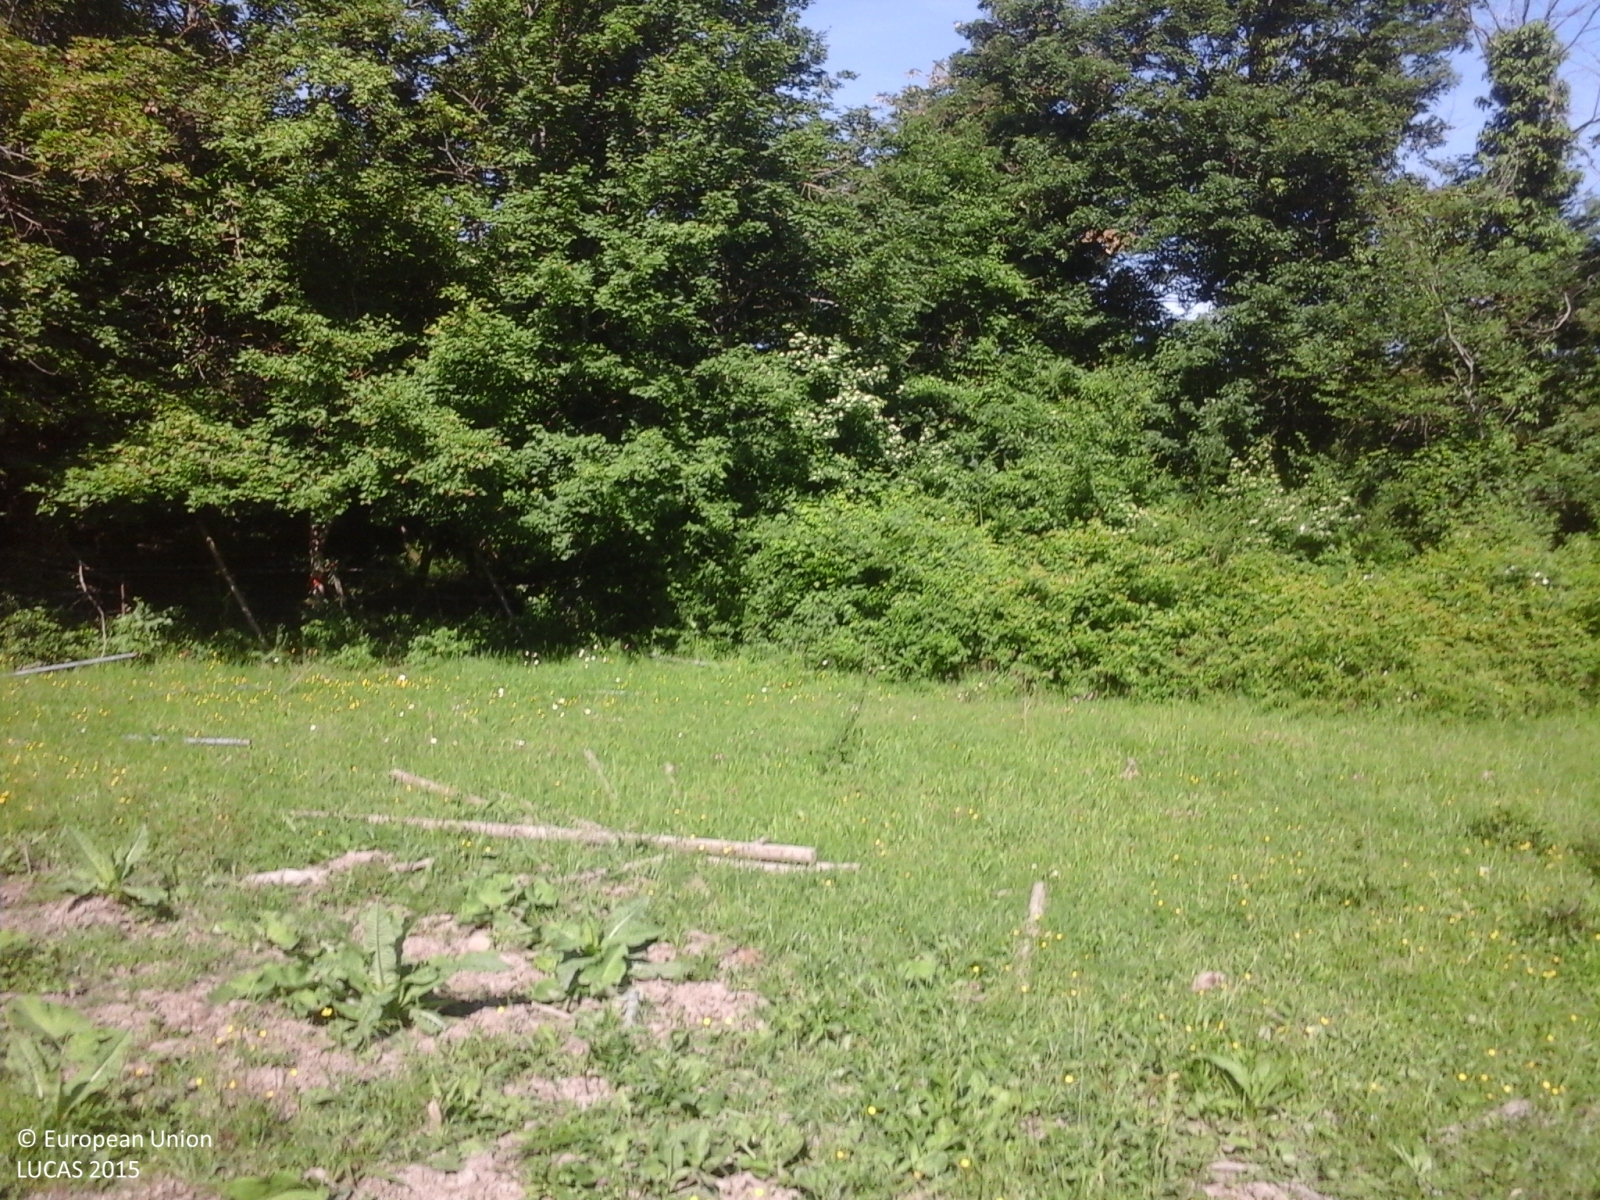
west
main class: Grassland
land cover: Grassland with sparse tree/shrub cover
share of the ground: > 75 %
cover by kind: herbaceous plants 90 %, broadleaved forest trees 5 %, shrubs 5 %
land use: Agriculture (excluding fallow land and kitchen gardens)
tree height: < 5 m
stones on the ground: 10 - 25 %
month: May
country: IT
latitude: 44.1477
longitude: 10.9603
